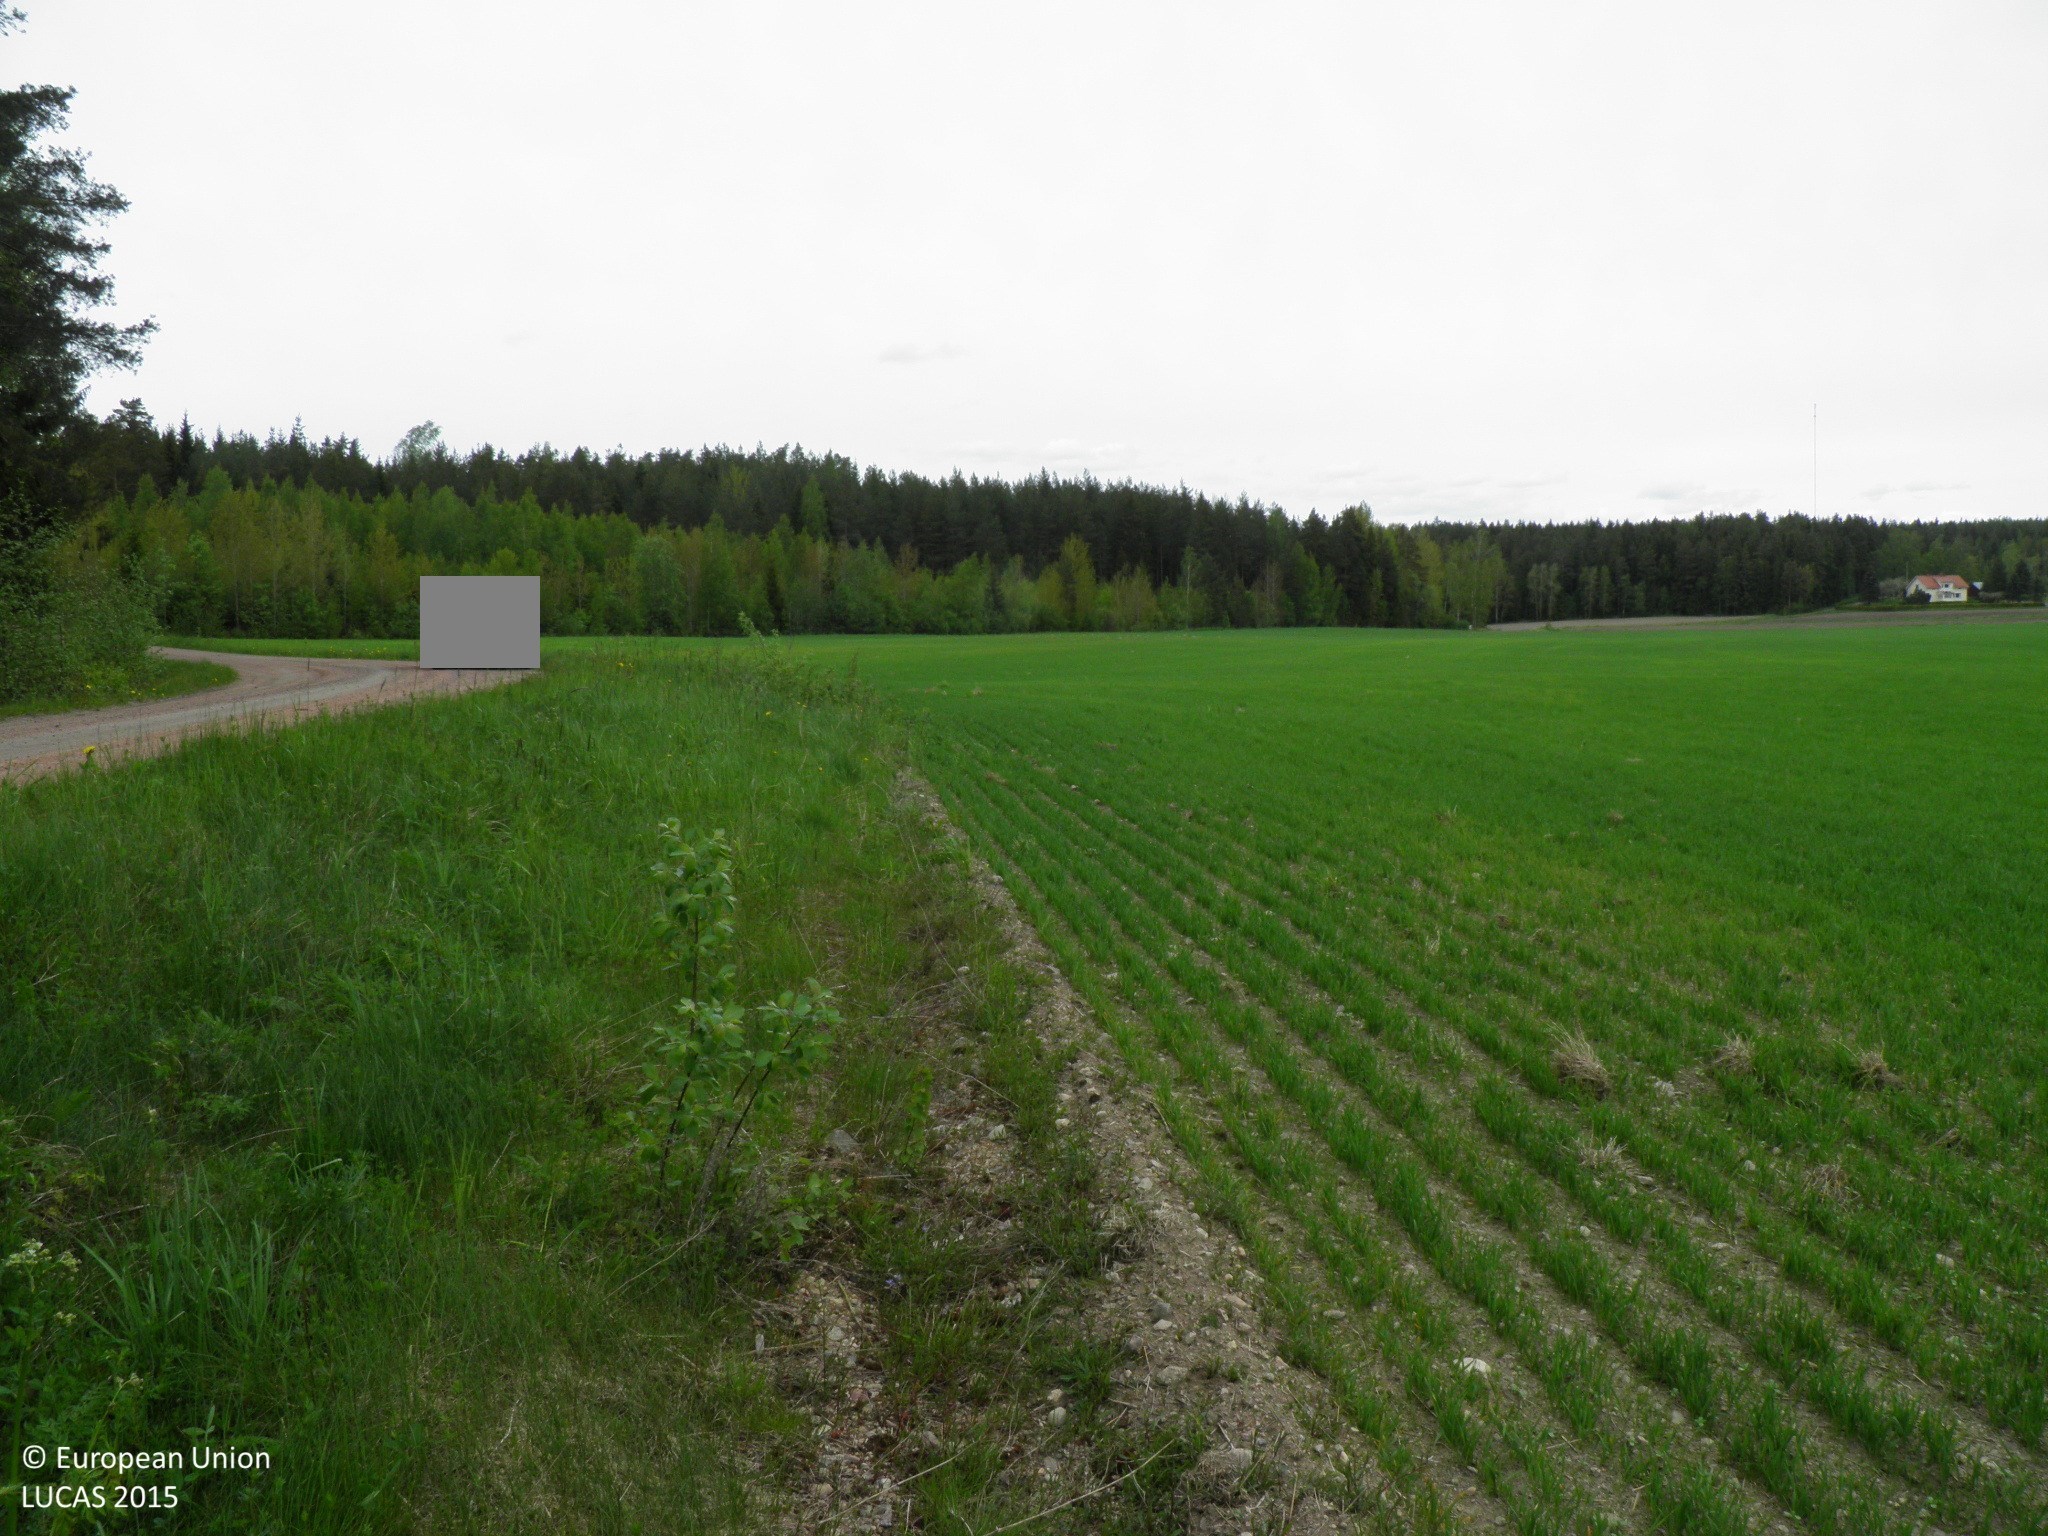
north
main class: Cropland
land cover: Oats
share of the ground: 50 - 75 %
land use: Agriculture (excluding fallow land and kitchen gardens)
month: June
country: FI
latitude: 60.5031
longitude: 22.6538
